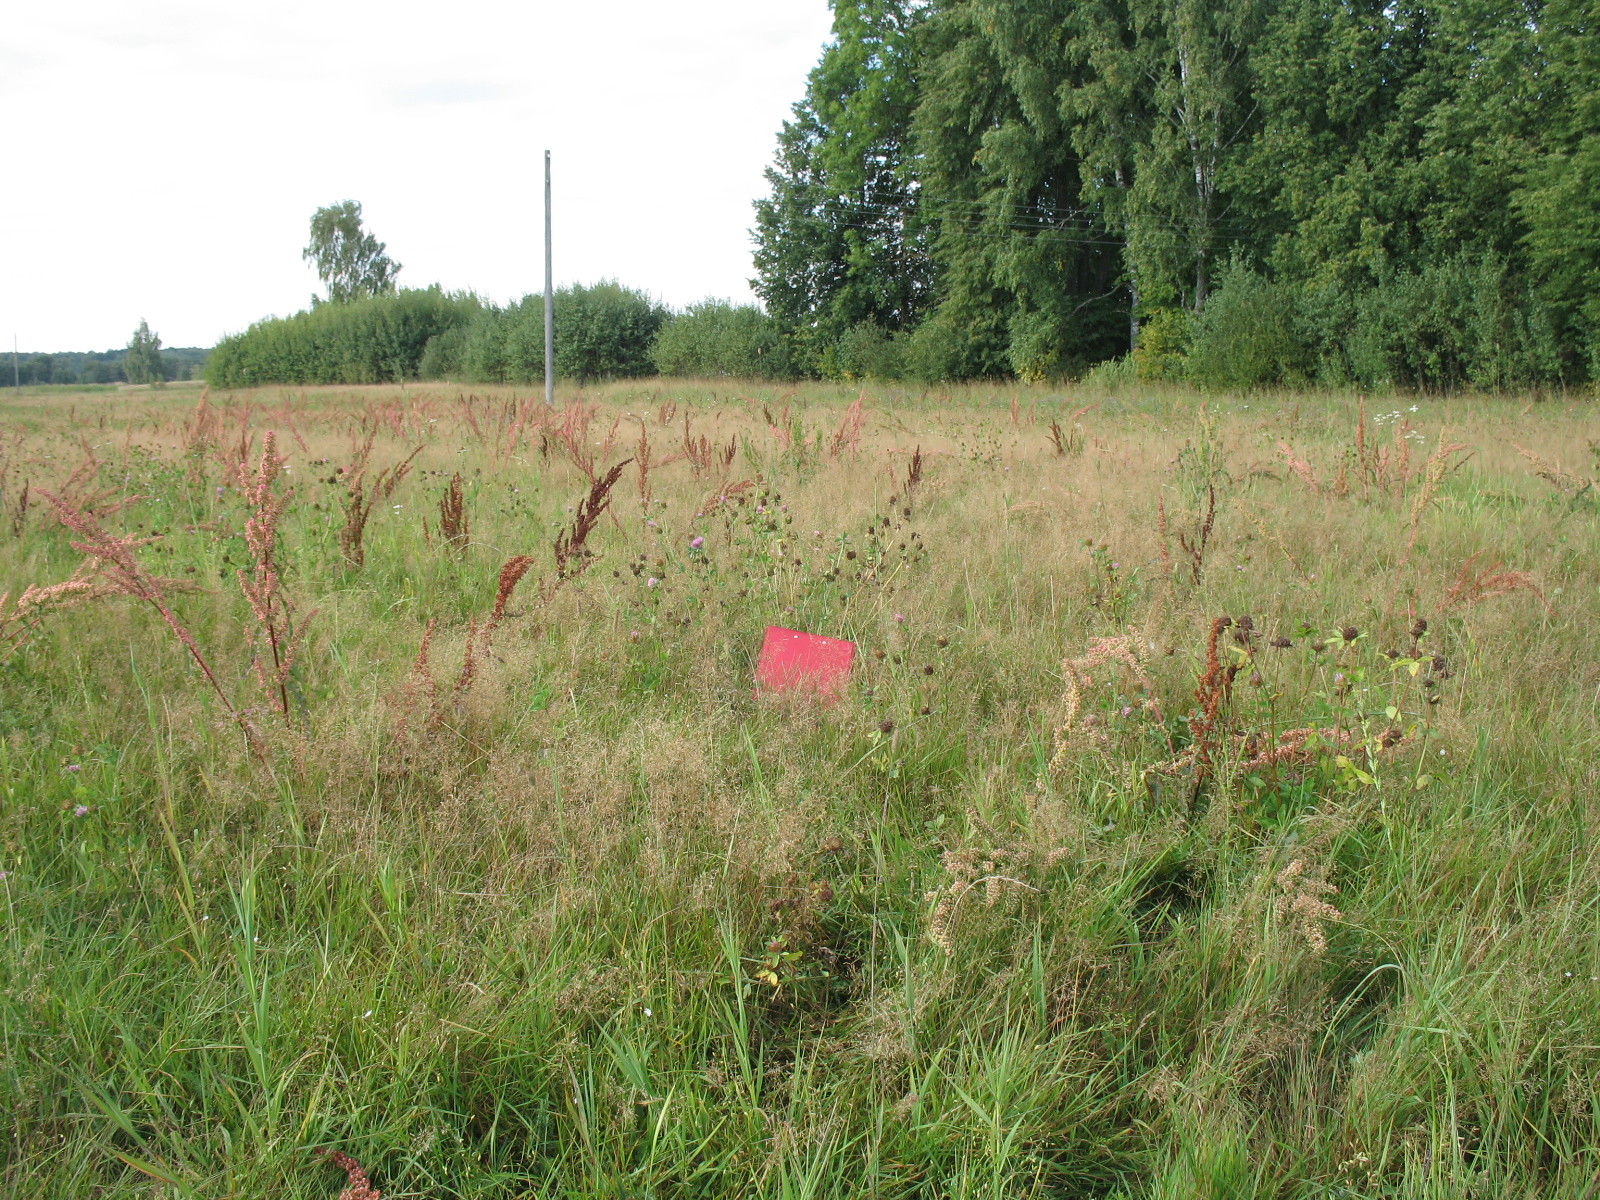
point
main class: Grassland
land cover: Grassland without tree/shrub cover
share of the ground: > 75 %
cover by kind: herbaceous plants 100 %
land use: Agriculture (excluding fallow land and kitchen gardens)
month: August
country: LV
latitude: 56.2968
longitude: 25.9860
